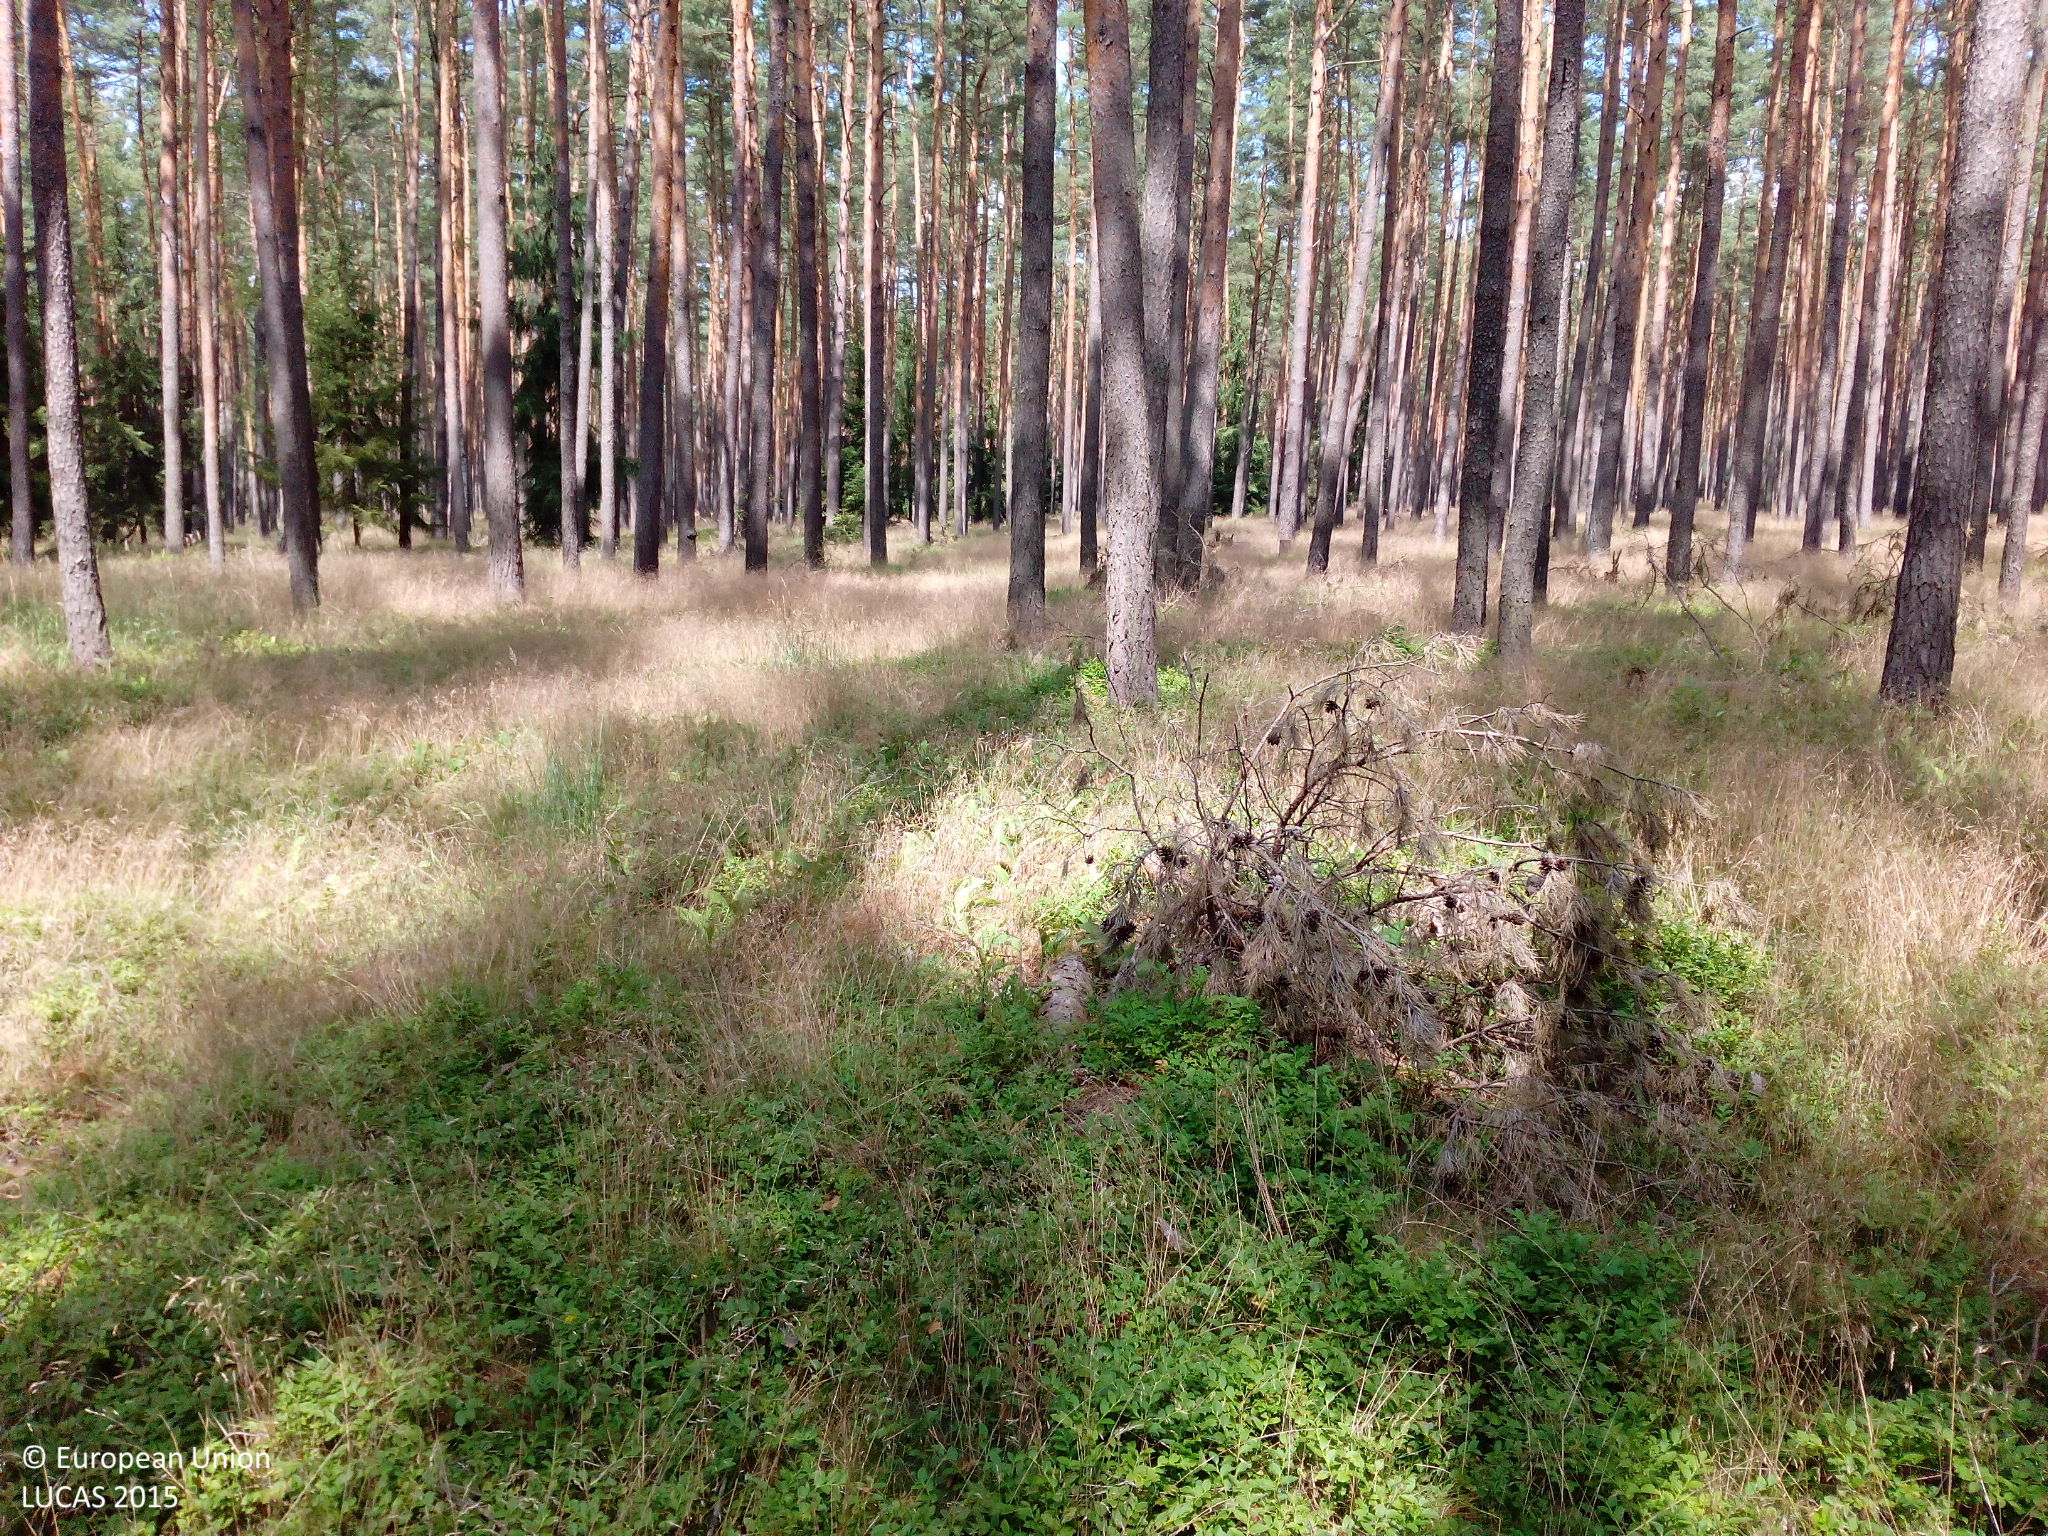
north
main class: Woodland
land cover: Pine dominated coniferous woodland
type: hemiboreal forest and nemoral coniferous forest and mixed broadleaved-coniferous forest
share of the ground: > 75 %
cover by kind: coniferous forest trees 75 %, herbaceous plants 20 %, lichens and mosses 5 %
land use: Forestry
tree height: > 5 m
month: July
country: DE
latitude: 52.3577
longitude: 14.1858
